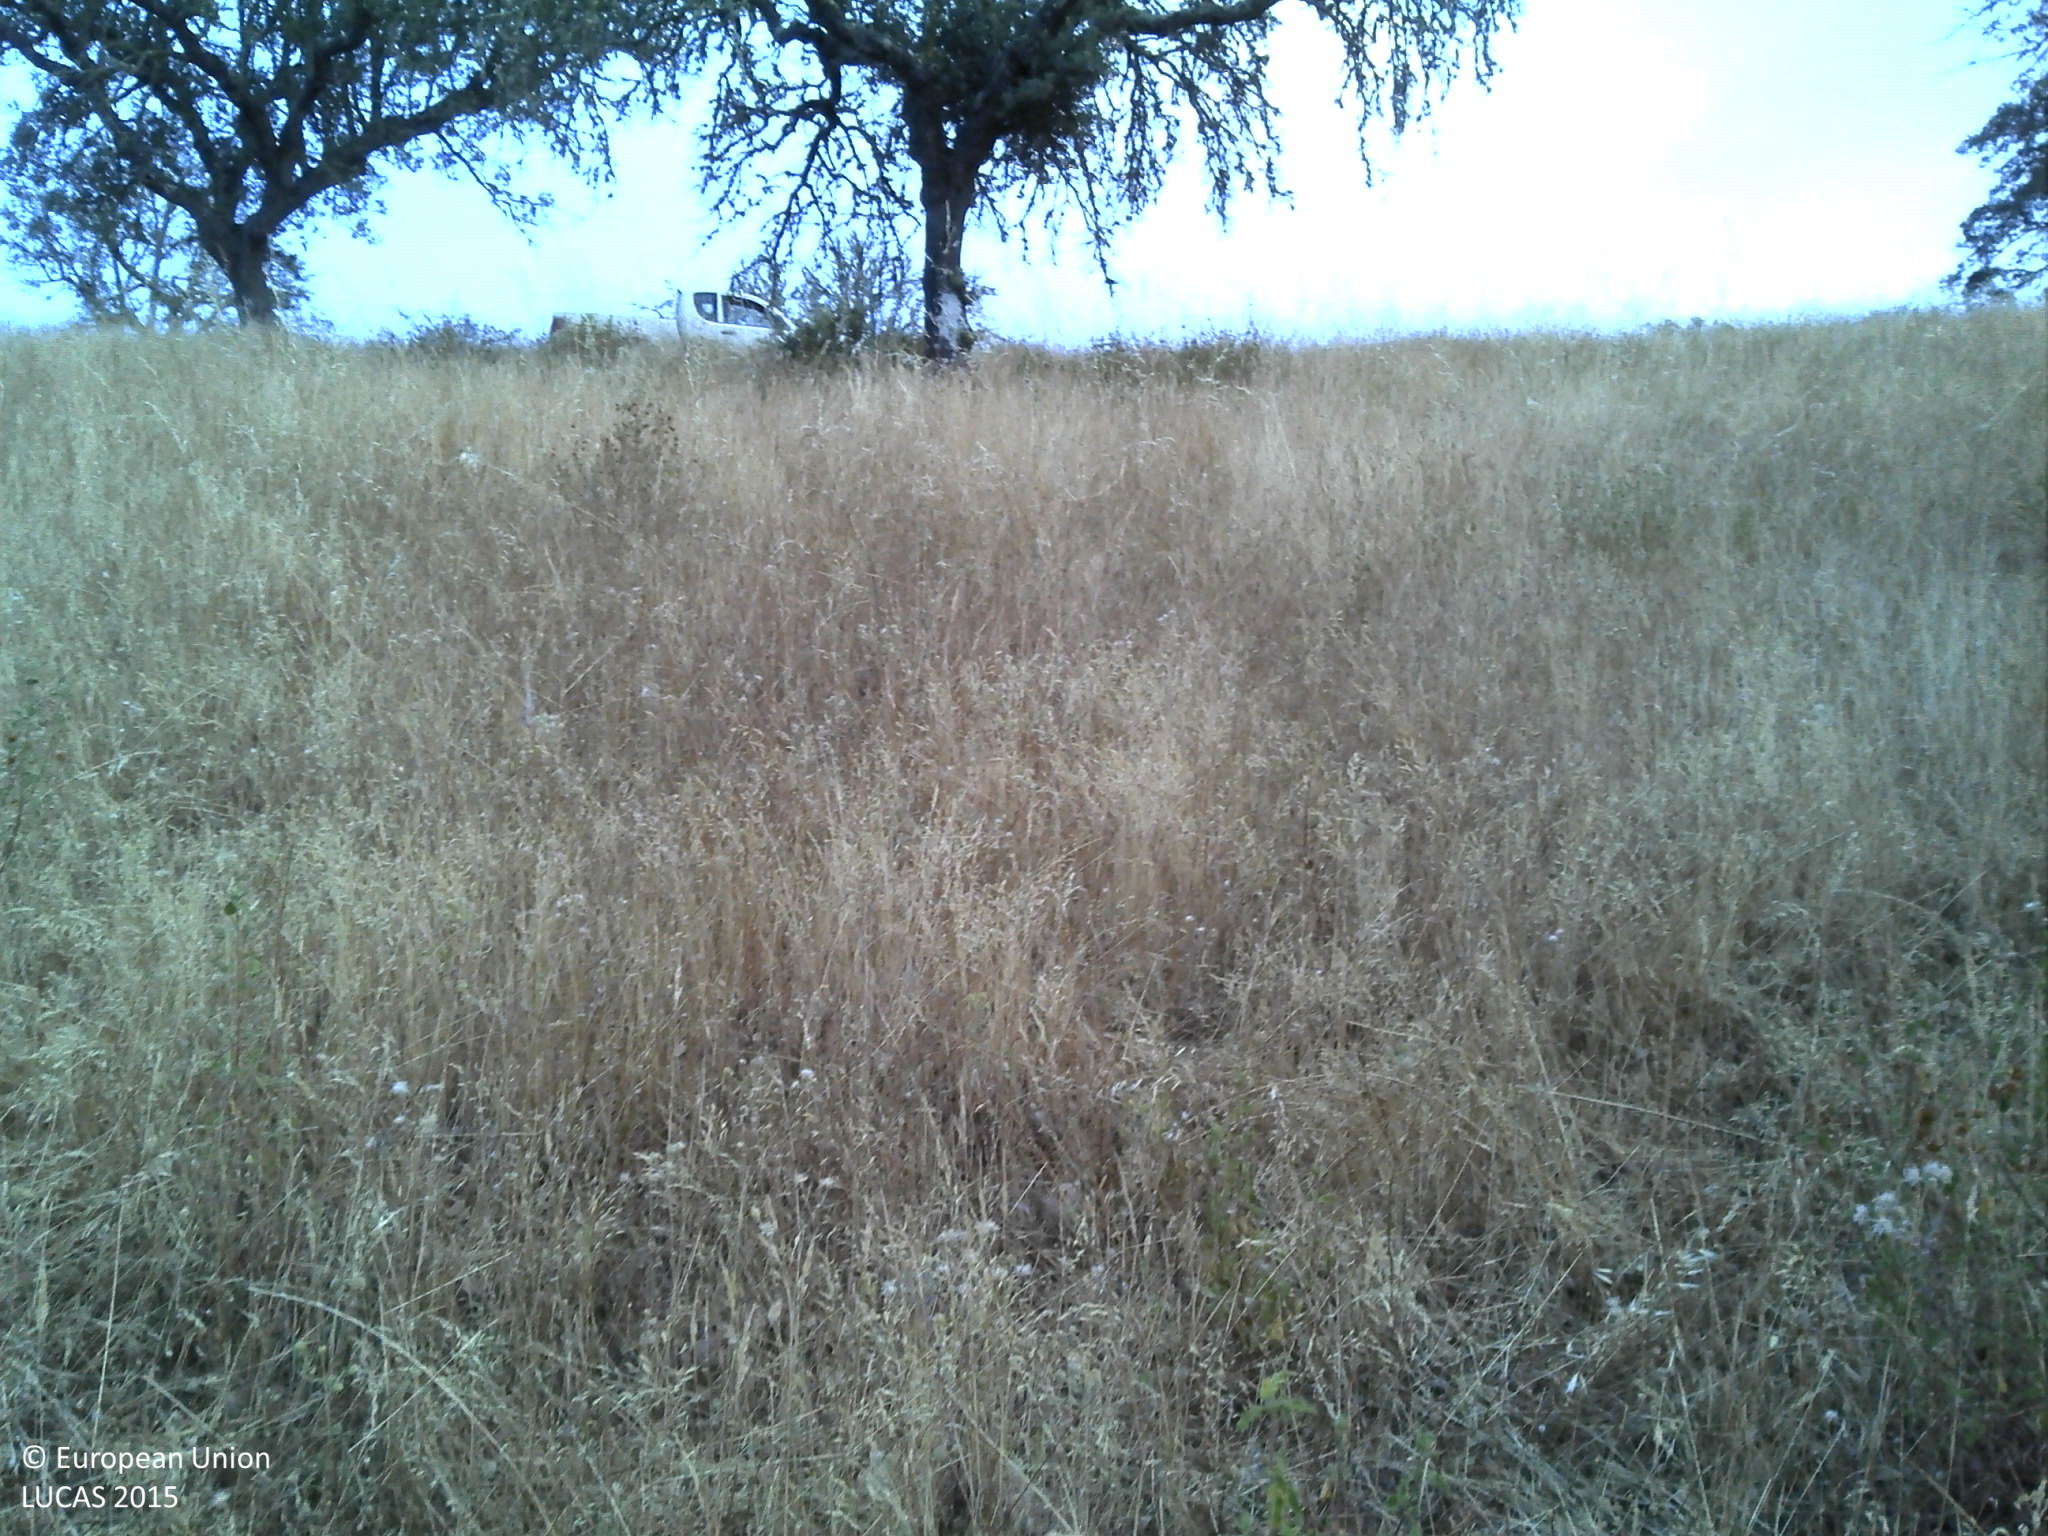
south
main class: Woodland
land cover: Broadleaved woodland
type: broadleaved evergreen forest
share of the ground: 25 - 50 %
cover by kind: herbaceous plants 50 %, broadleaved forest trees 45 %, unconsolidated bare surface 5 %
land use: Forestry
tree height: > 5 m
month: June
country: PT
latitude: 37.8398
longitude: -7.5506
